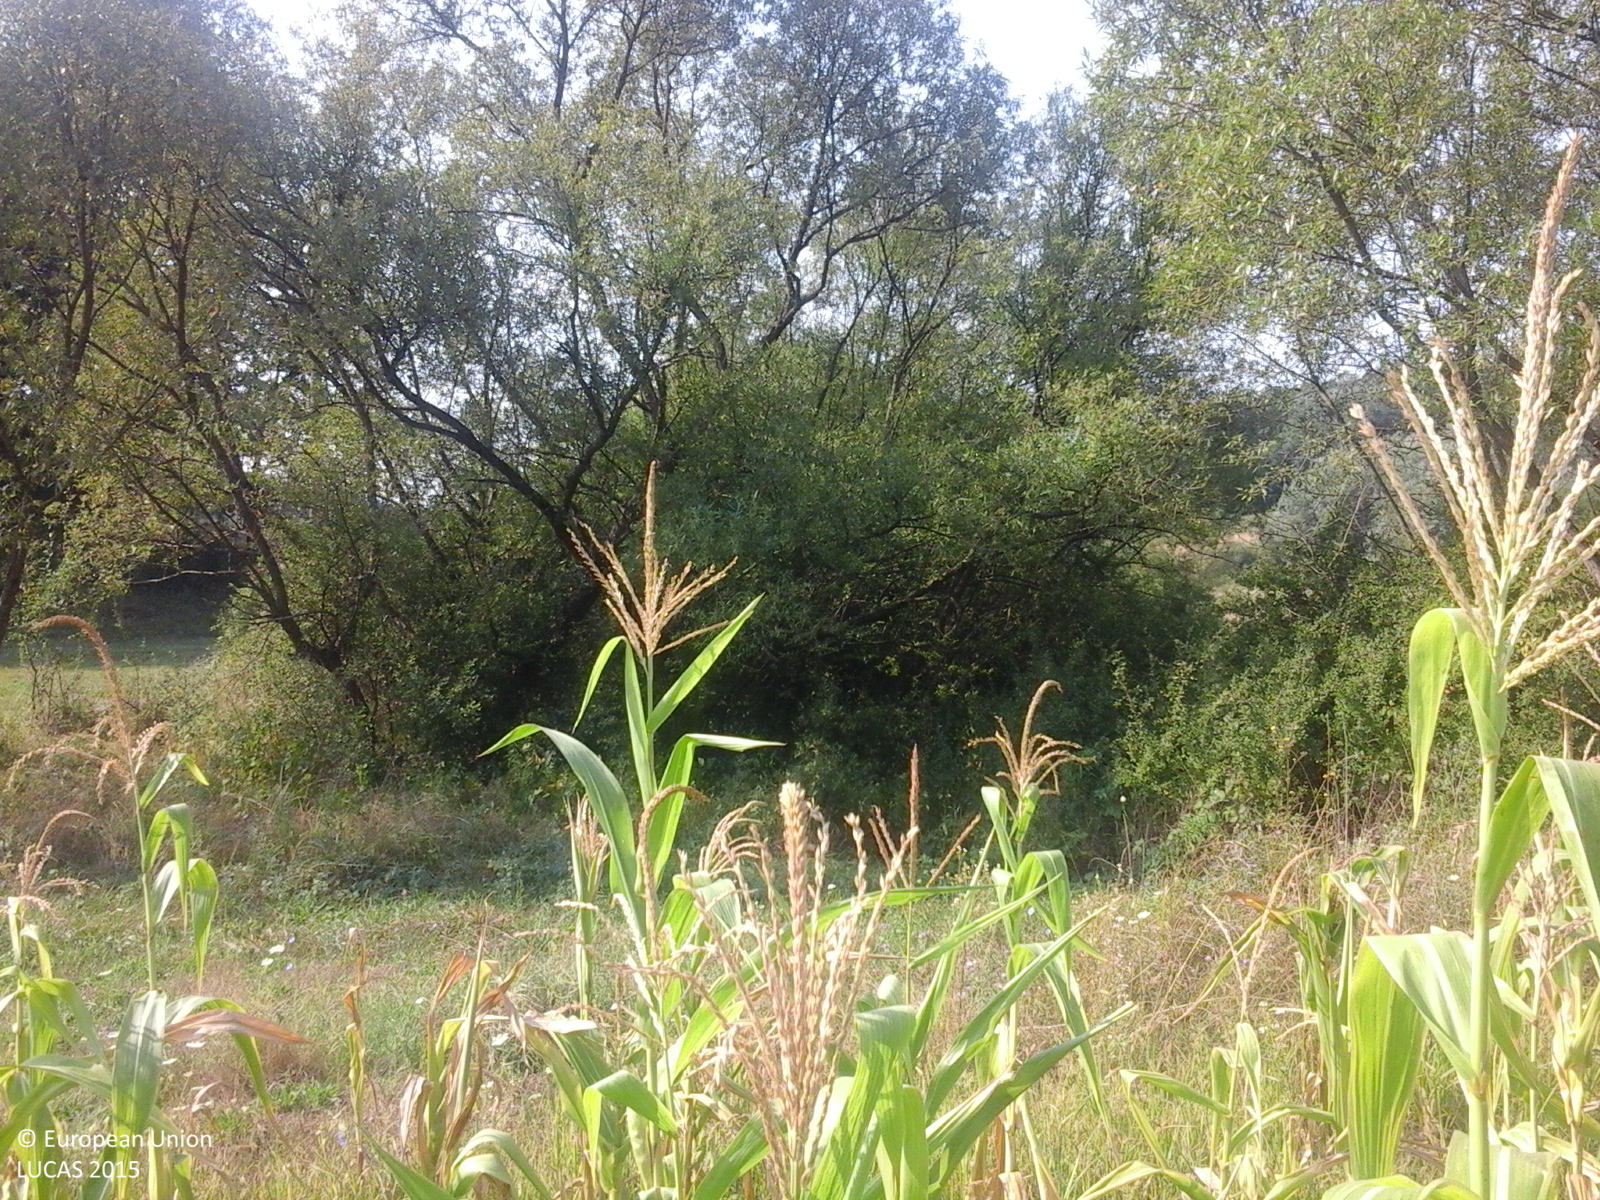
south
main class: Cropland
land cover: Maize
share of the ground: > 75 %
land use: Agriculture (excluding fallow land and kitchen gardens)
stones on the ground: < 10 %
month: August
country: RO
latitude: 44.6214
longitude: 23.8609
